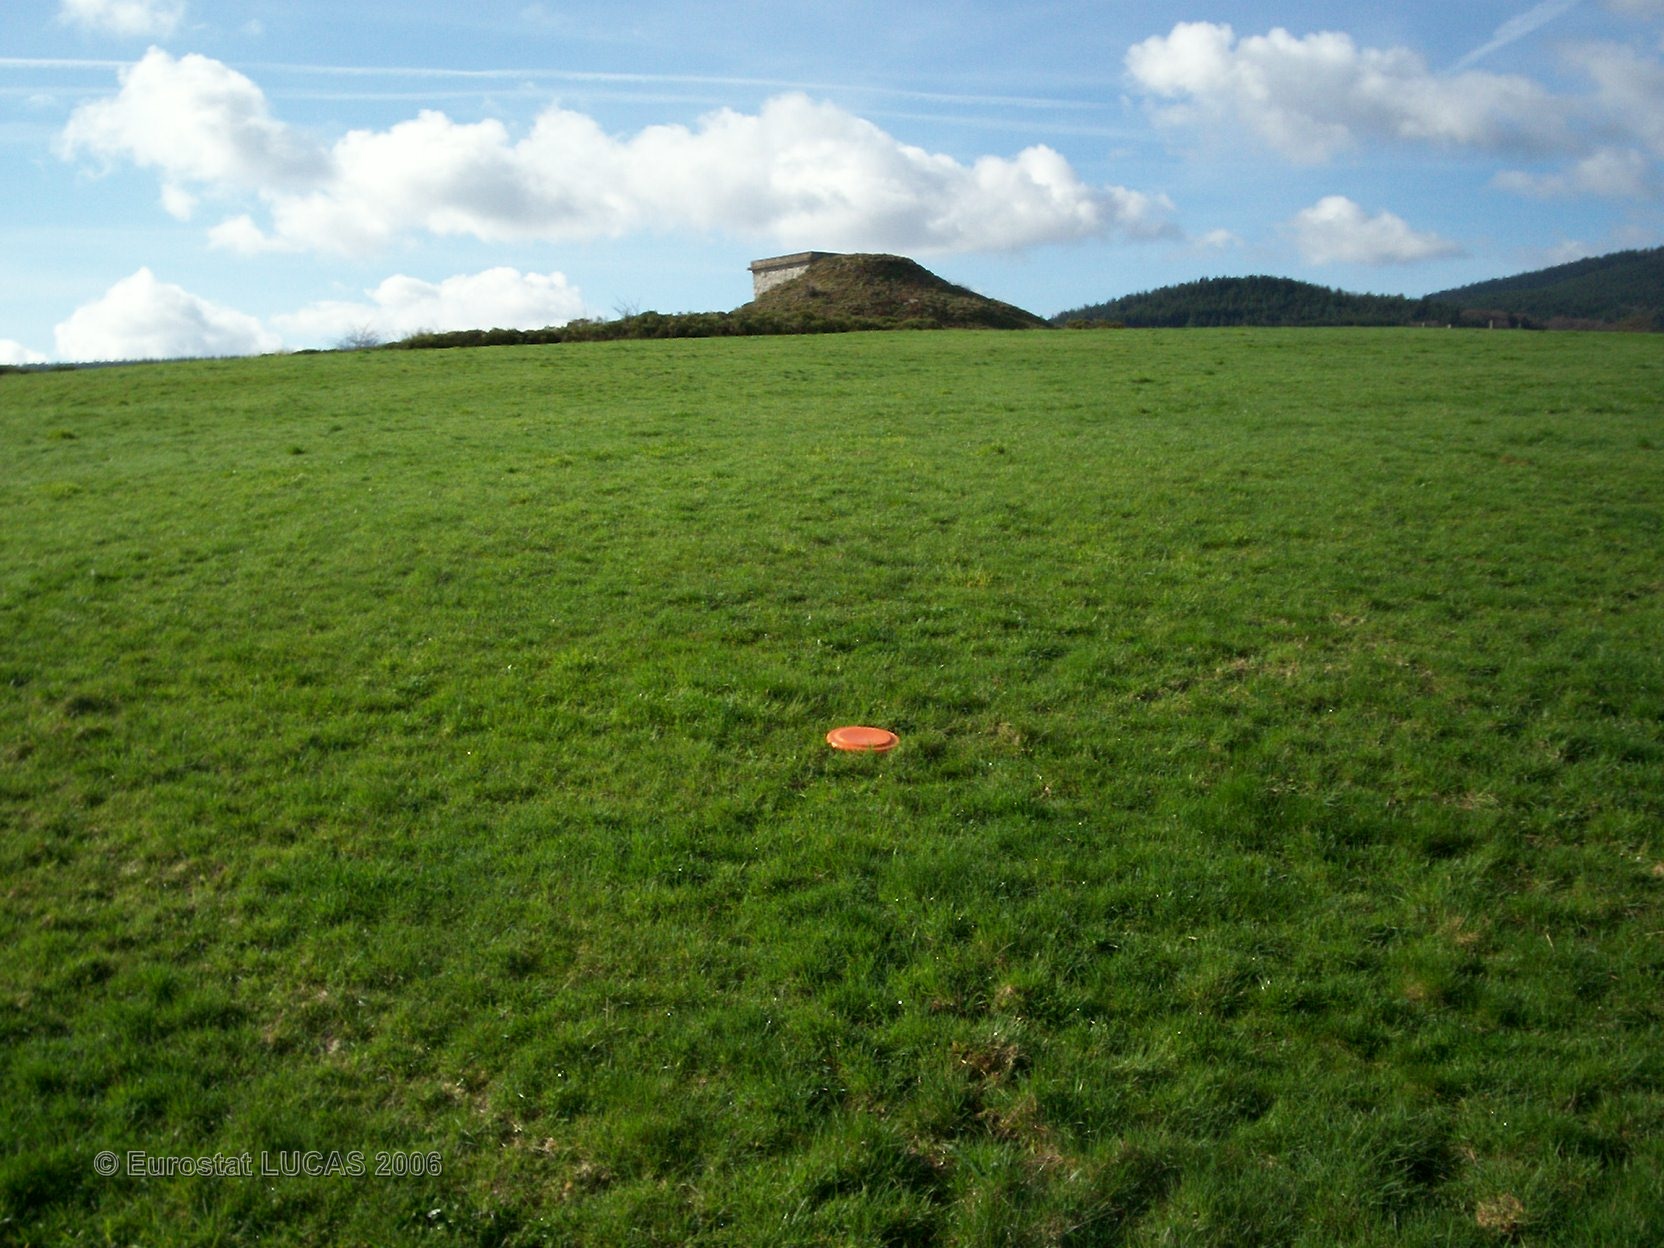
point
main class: Grassland
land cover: Grassland without tree/shrub cover
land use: Agriculture (excluding fallow land and kitchen gardens)
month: April
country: FR
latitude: 45.0603
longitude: 3.3612
